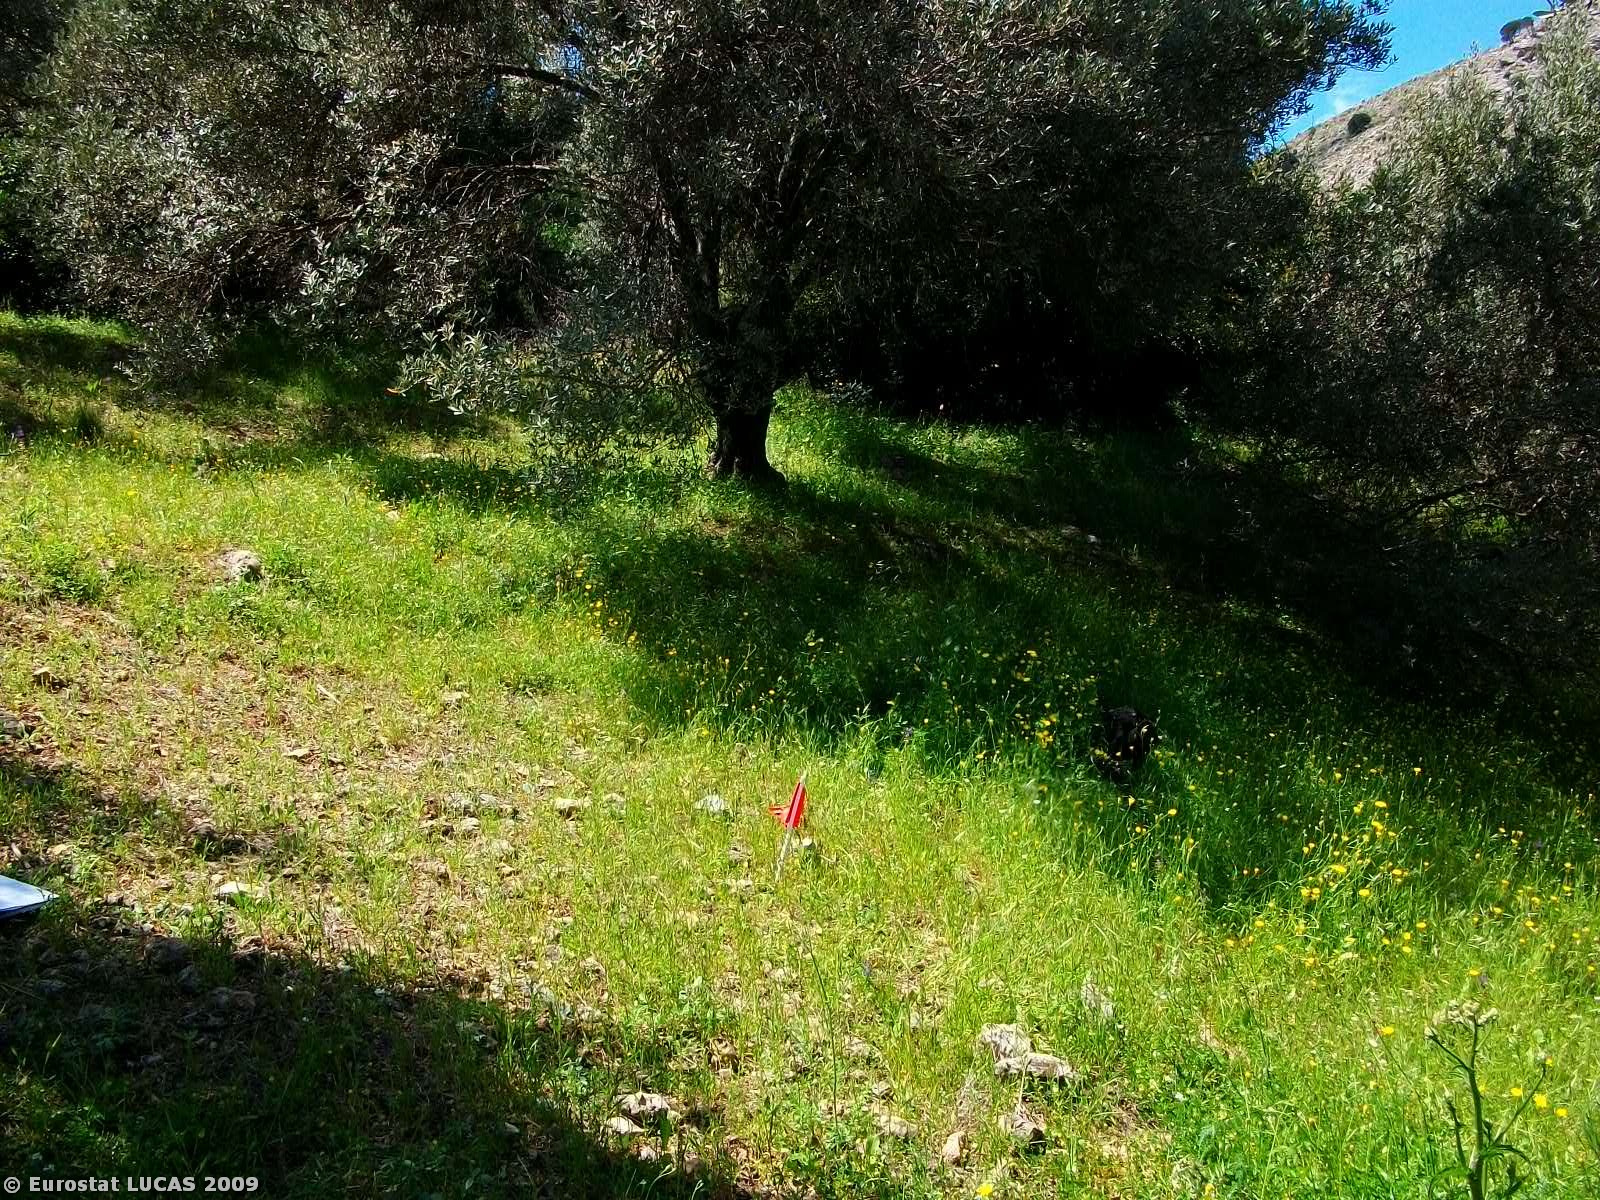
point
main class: Cropland
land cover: Olive groves
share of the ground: 50 - 75 %
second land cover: Grassland with sparse tree/shrub cover
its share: > 75 %
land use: Agriculture (excluding fallow land and kitchen gardens)
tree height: < 5 m
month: April
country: GR
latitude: 35.2973
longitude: 25.0016
